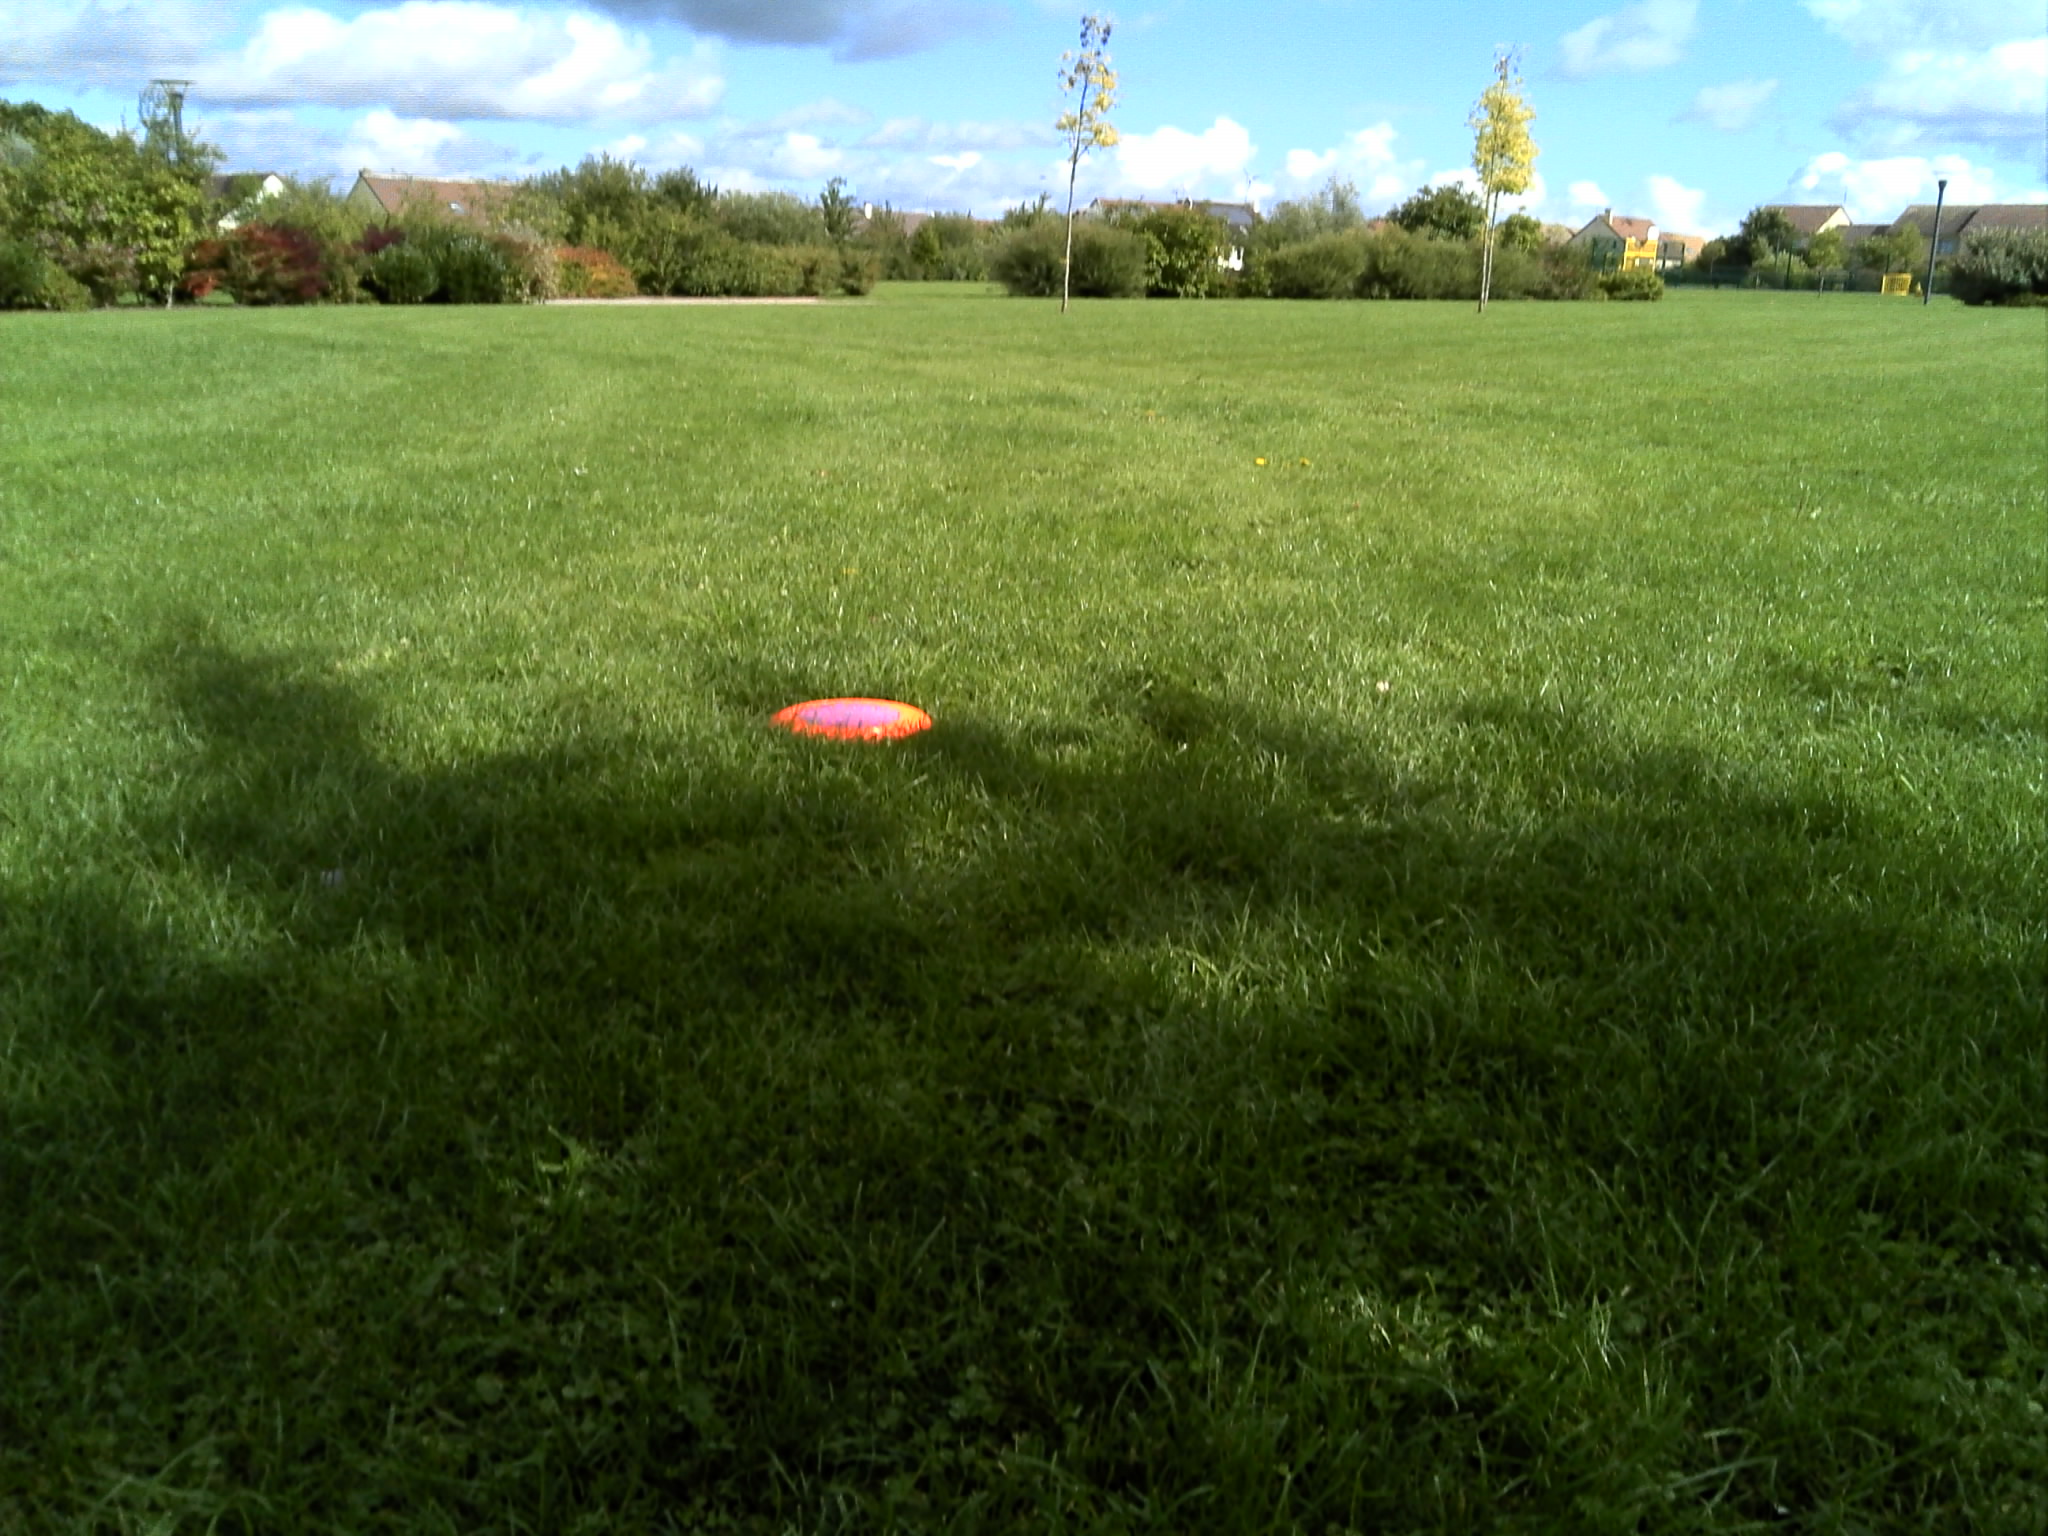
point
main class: Grassland
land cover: Grassland without tree/shrub cover
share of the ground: > 75 %
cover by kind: herbaceous plants 100 %
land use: Community services
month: September
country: FR
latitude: 48.1703
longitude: 0.6589
